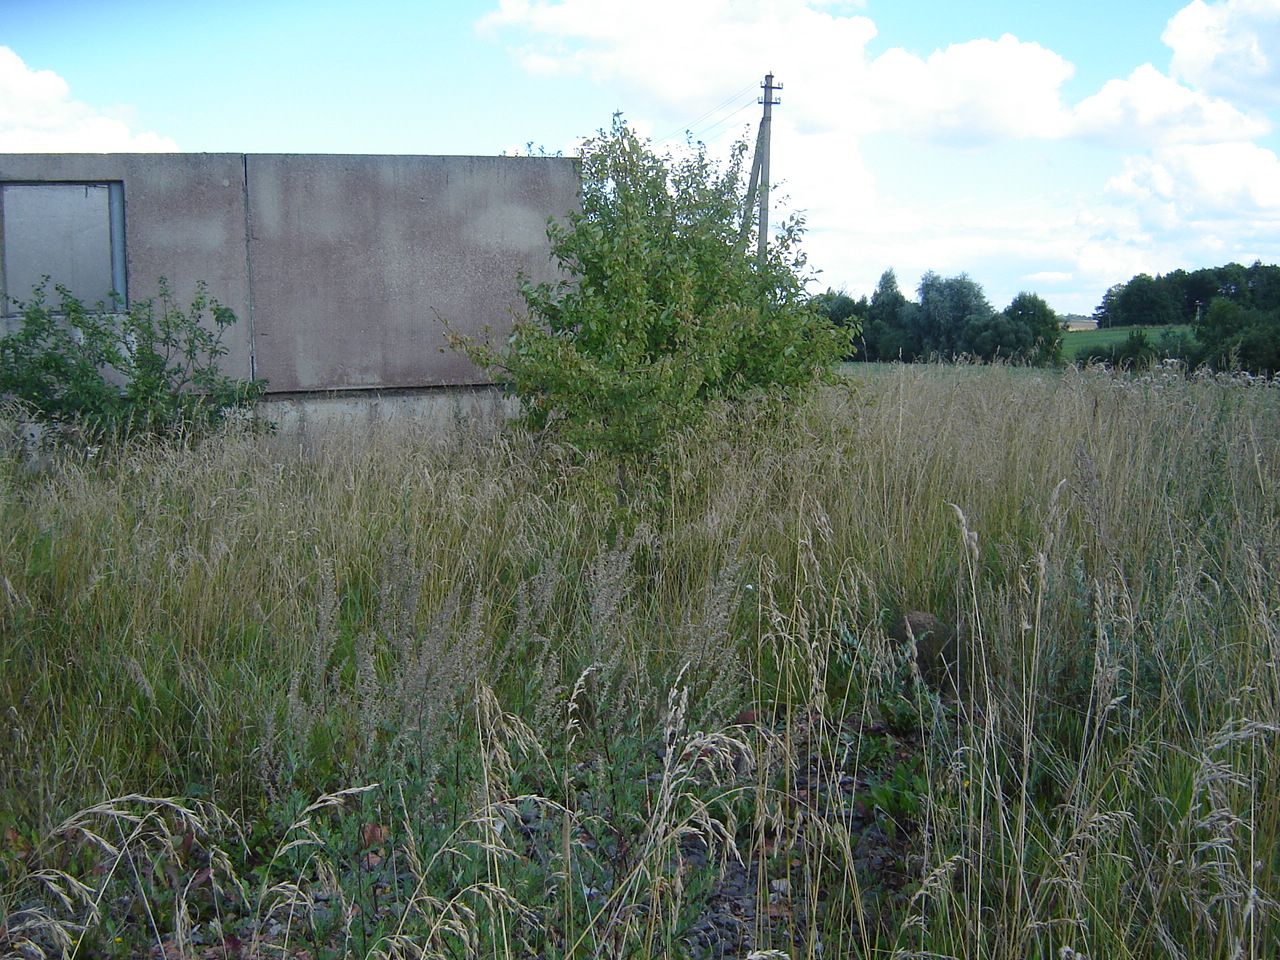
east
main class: Grassland
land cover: Spontaneously vegetated surfaces
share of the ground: > 75 %
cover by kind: herbaceous plants 95 %, shrubs 5 %
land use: Abandoned areas
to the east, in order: Spontaneously vegetated surfaces; Artificial constructions in urban areas; Spontaneously vegetated surfaces; Electric lines; Grassland without tree/shrub cover; Spontaneously vegetated surfaces; Grassland without tree/shrub cover; Artificial constructions in urban areas
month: August
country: LT
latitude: 55.0187
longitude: 24.8909
